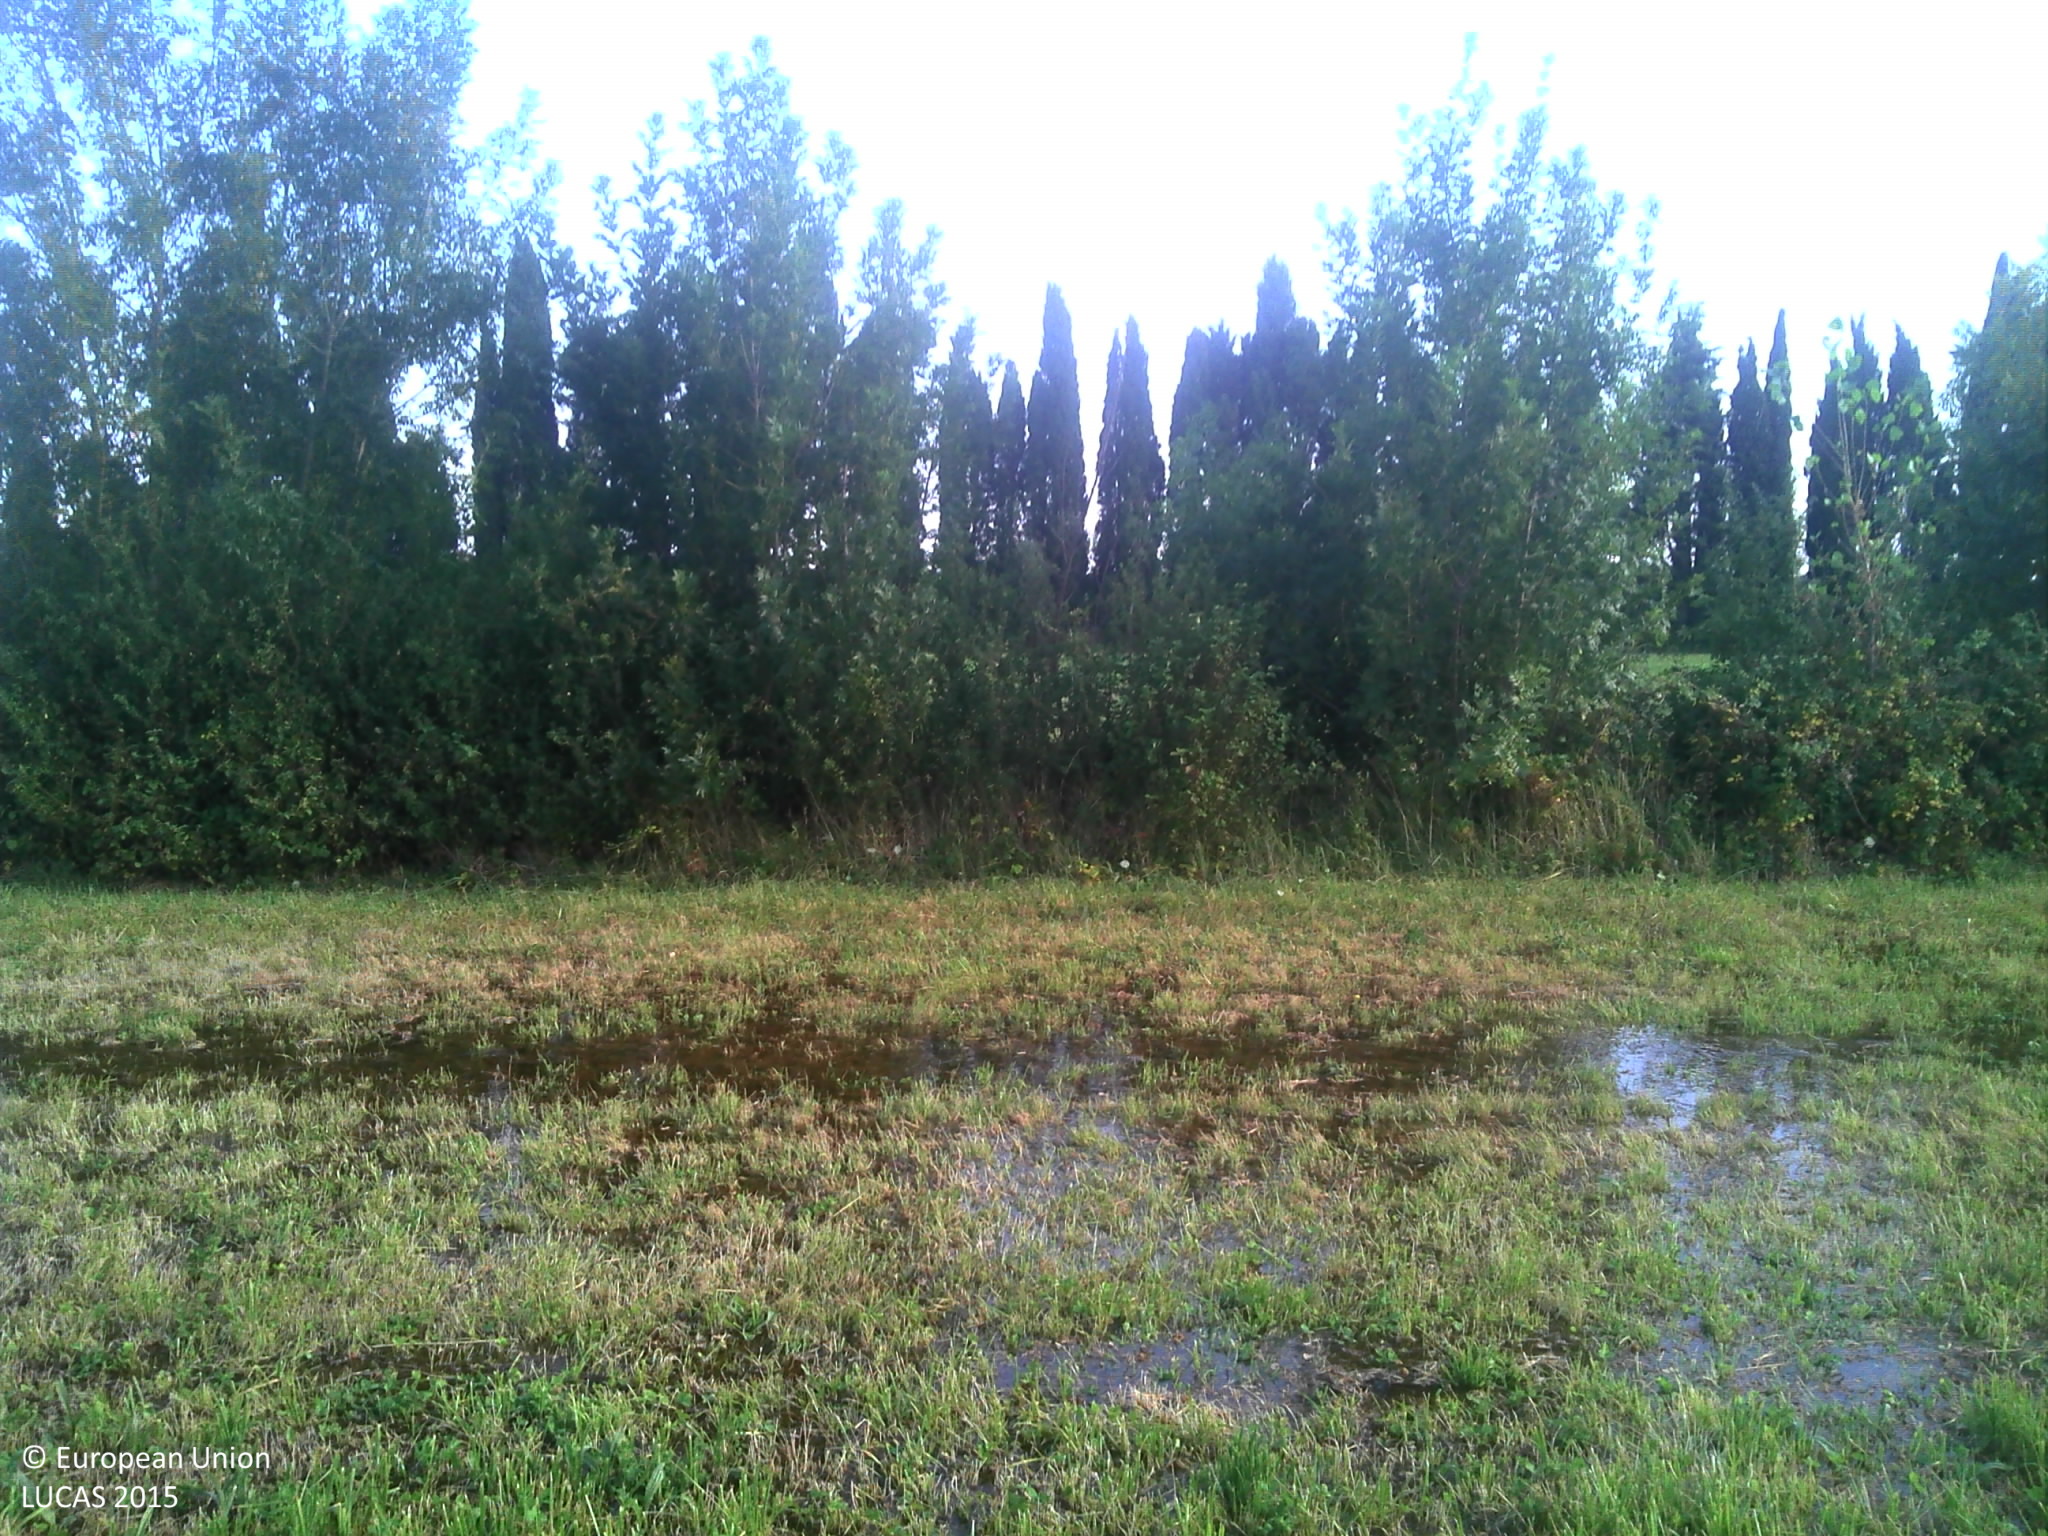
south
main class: Grassland
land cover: Grassland without tree/shrub cover
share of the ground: > 75 %
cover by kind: herbaceous plants 95 %, shrubs 5 %
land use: Agriculture (excluding fallow land and kitchen gardens)
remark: Temporary flooded
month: July
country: FR
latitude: 43.6919
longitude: 5.0838
